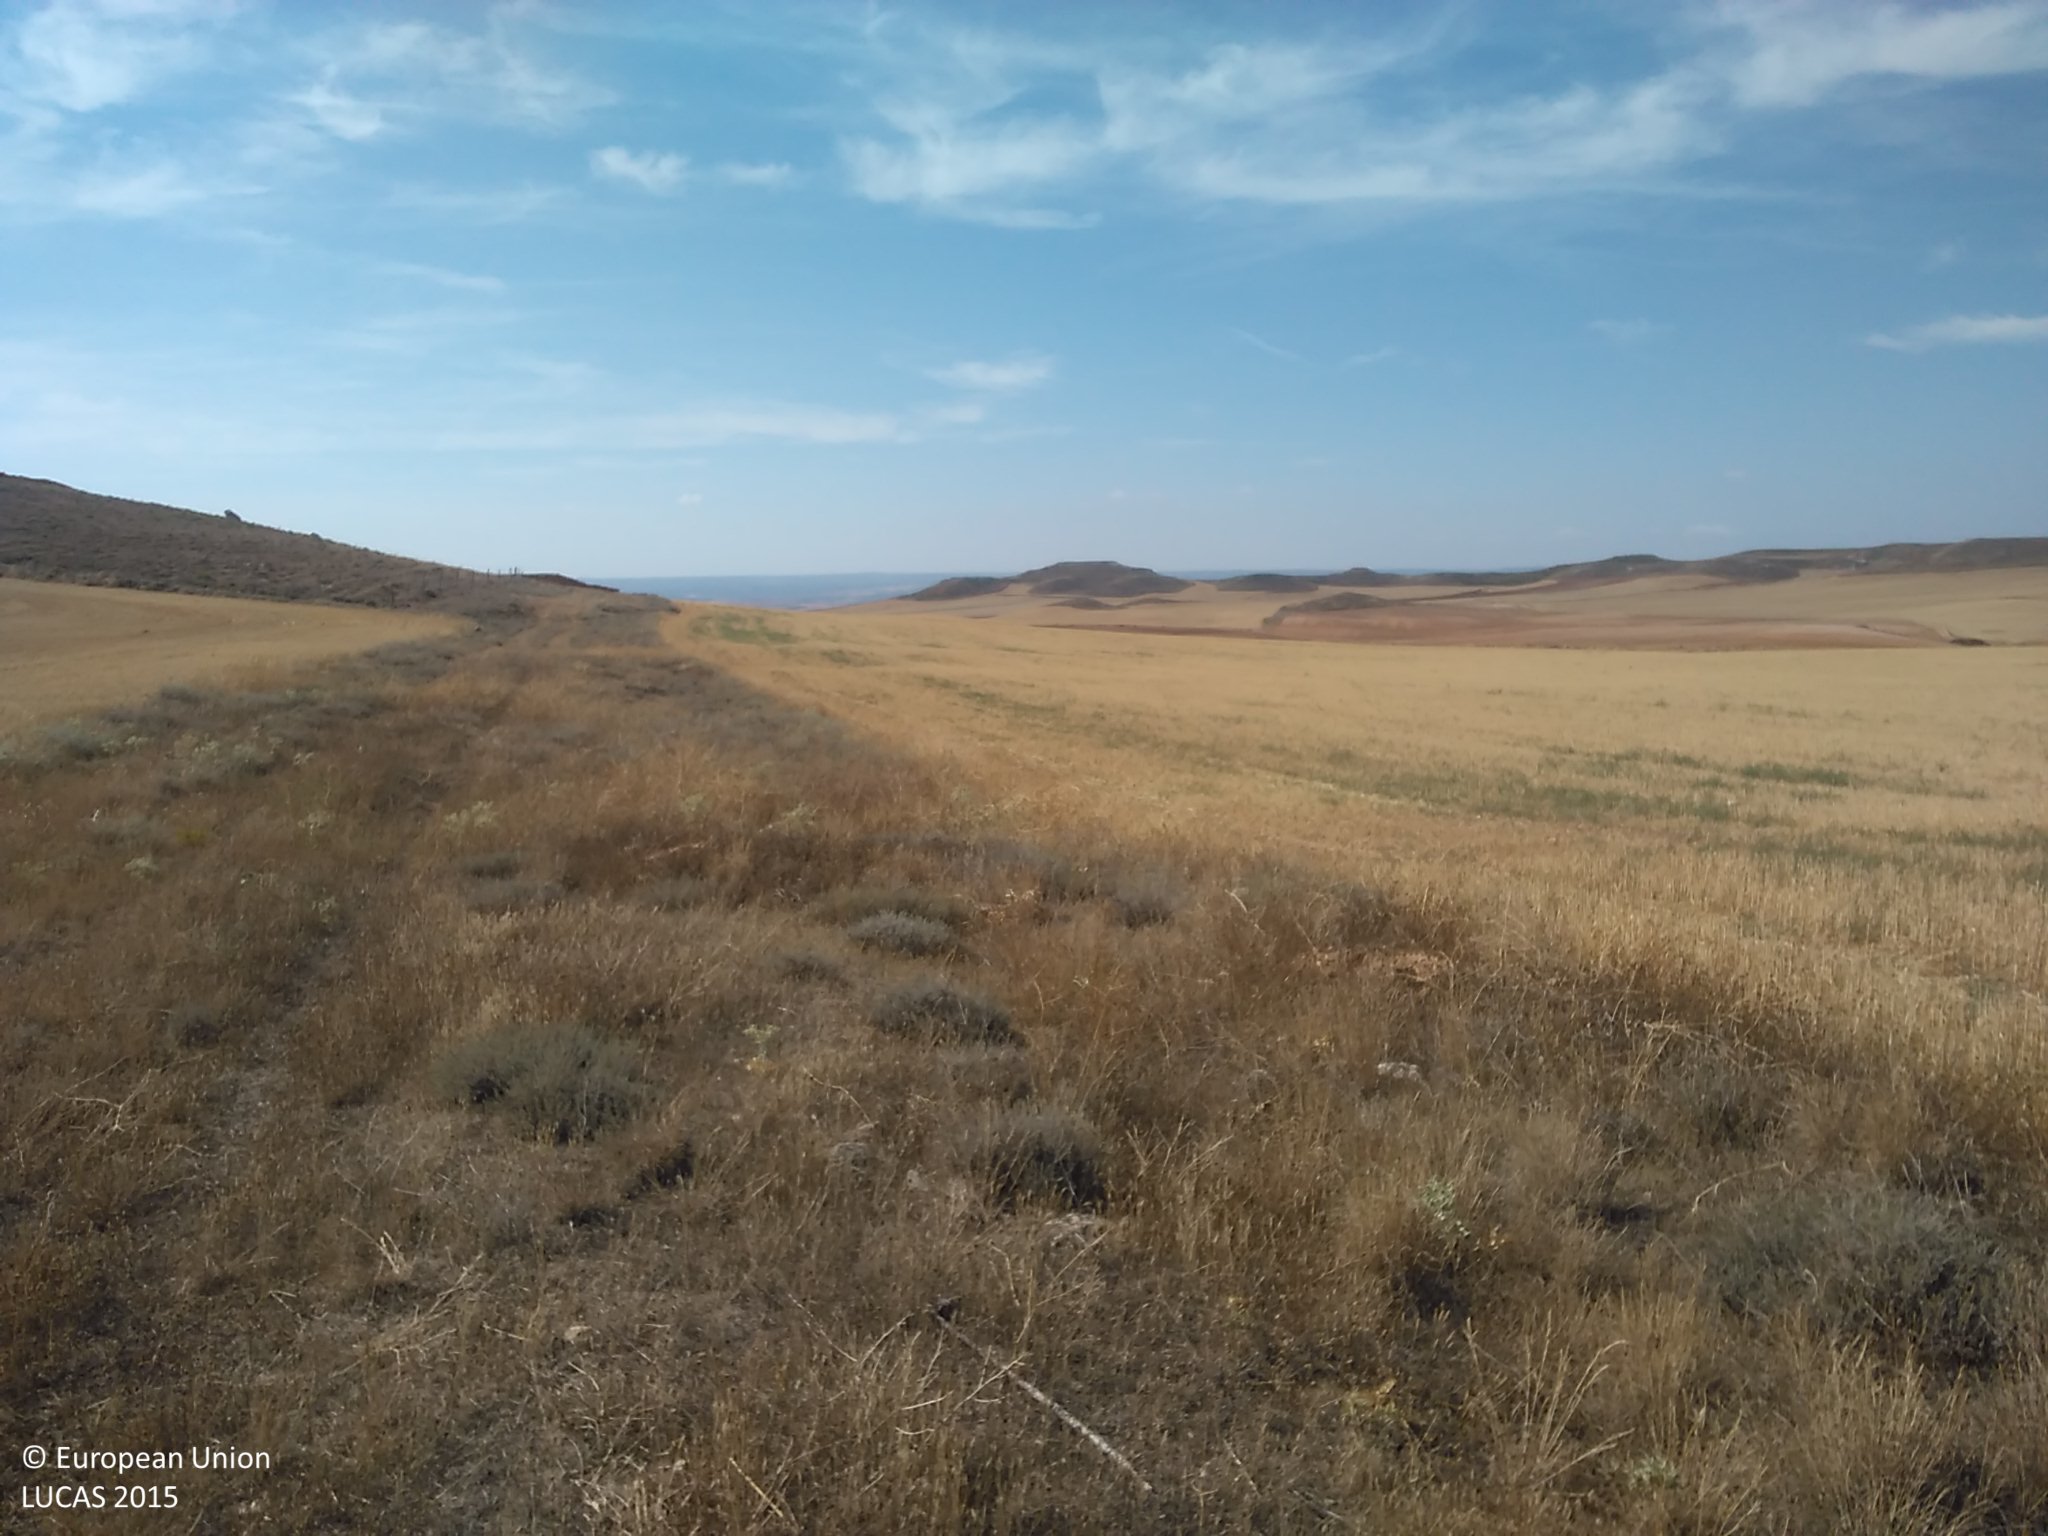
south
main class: Shrubland
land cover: Shrubland without tree cover
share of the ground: 10 - 25 %
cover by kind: herbaceous plants 70 %, shrubs 20 %, unconsolidated bare surface 10 %
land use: Semi-natural and natural areas not in use
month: July
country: ES
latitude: 41.3289
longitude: -2.2056
